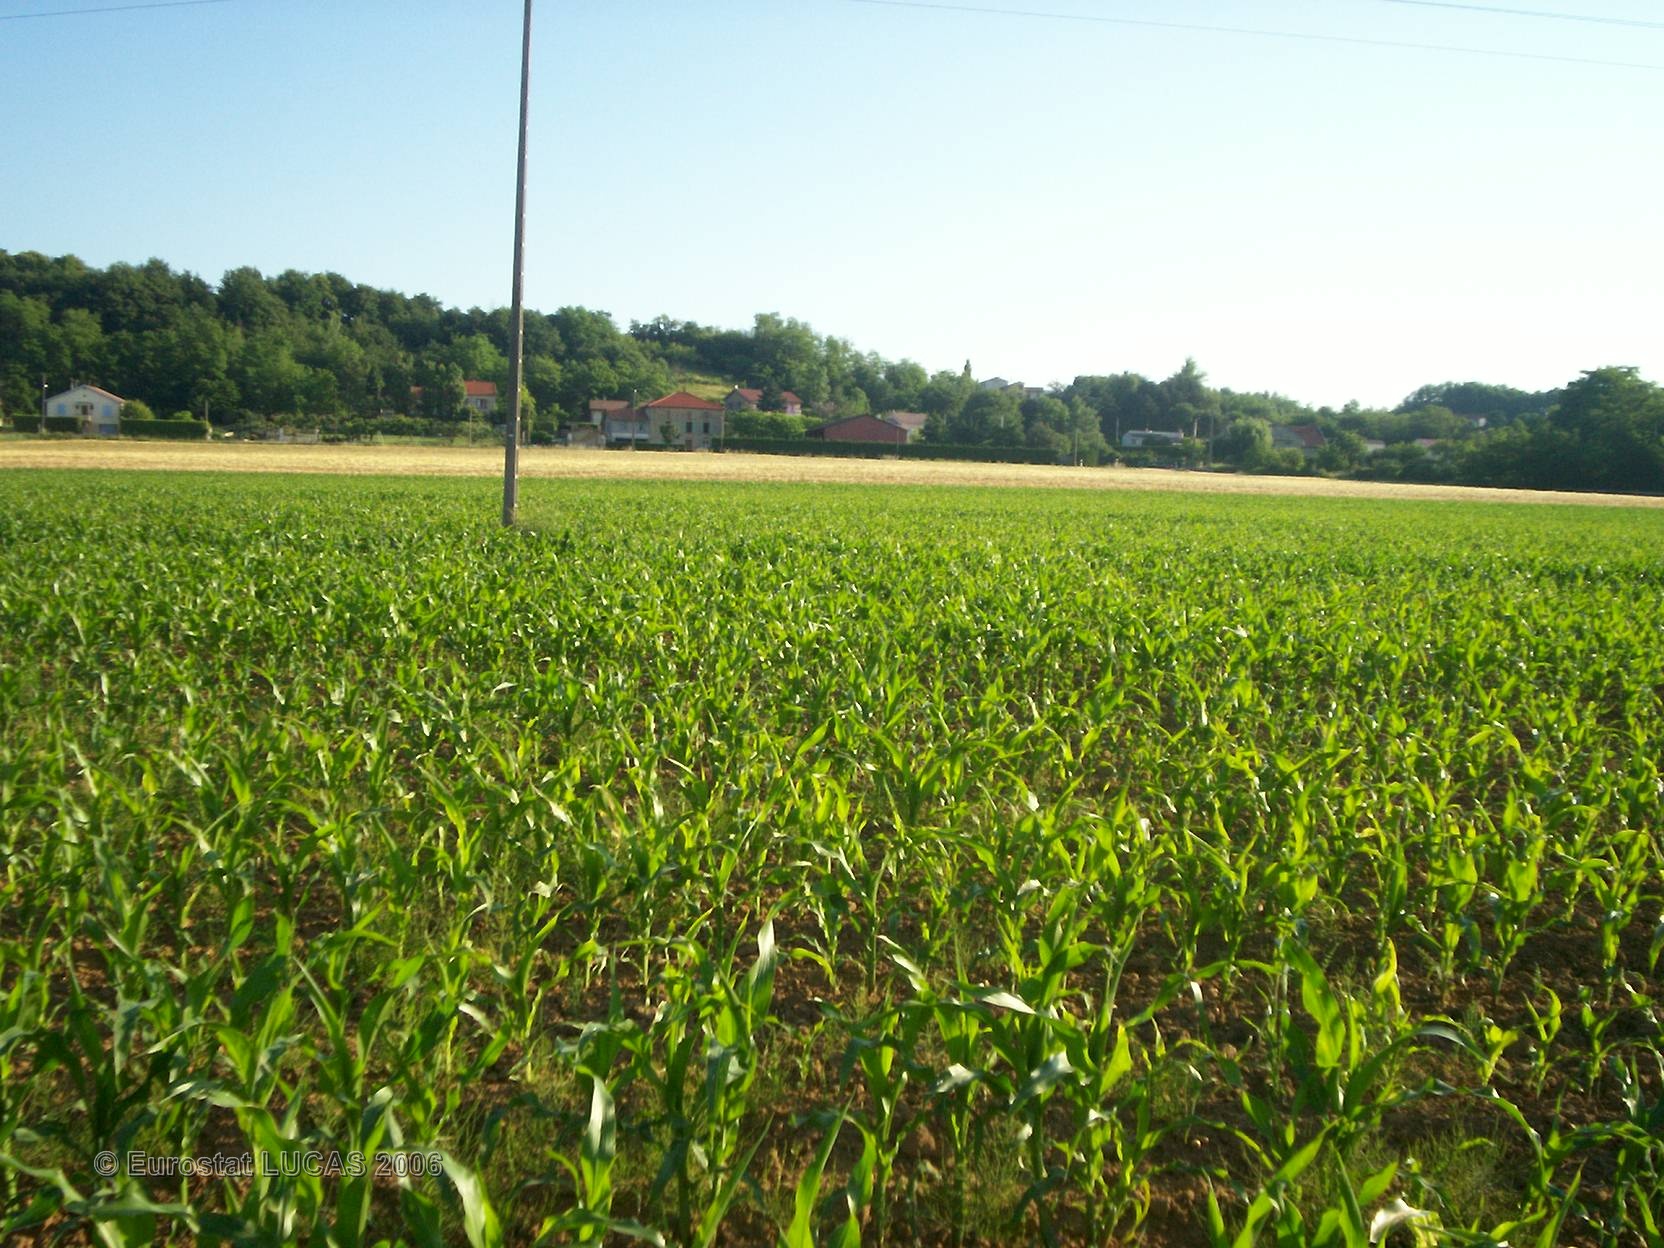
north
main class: Cropland
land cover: Maize
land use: Agriculture (excluding fallow land and kitchen gardens)
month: June
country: FR
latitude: 45.1814
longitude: 4.8764
